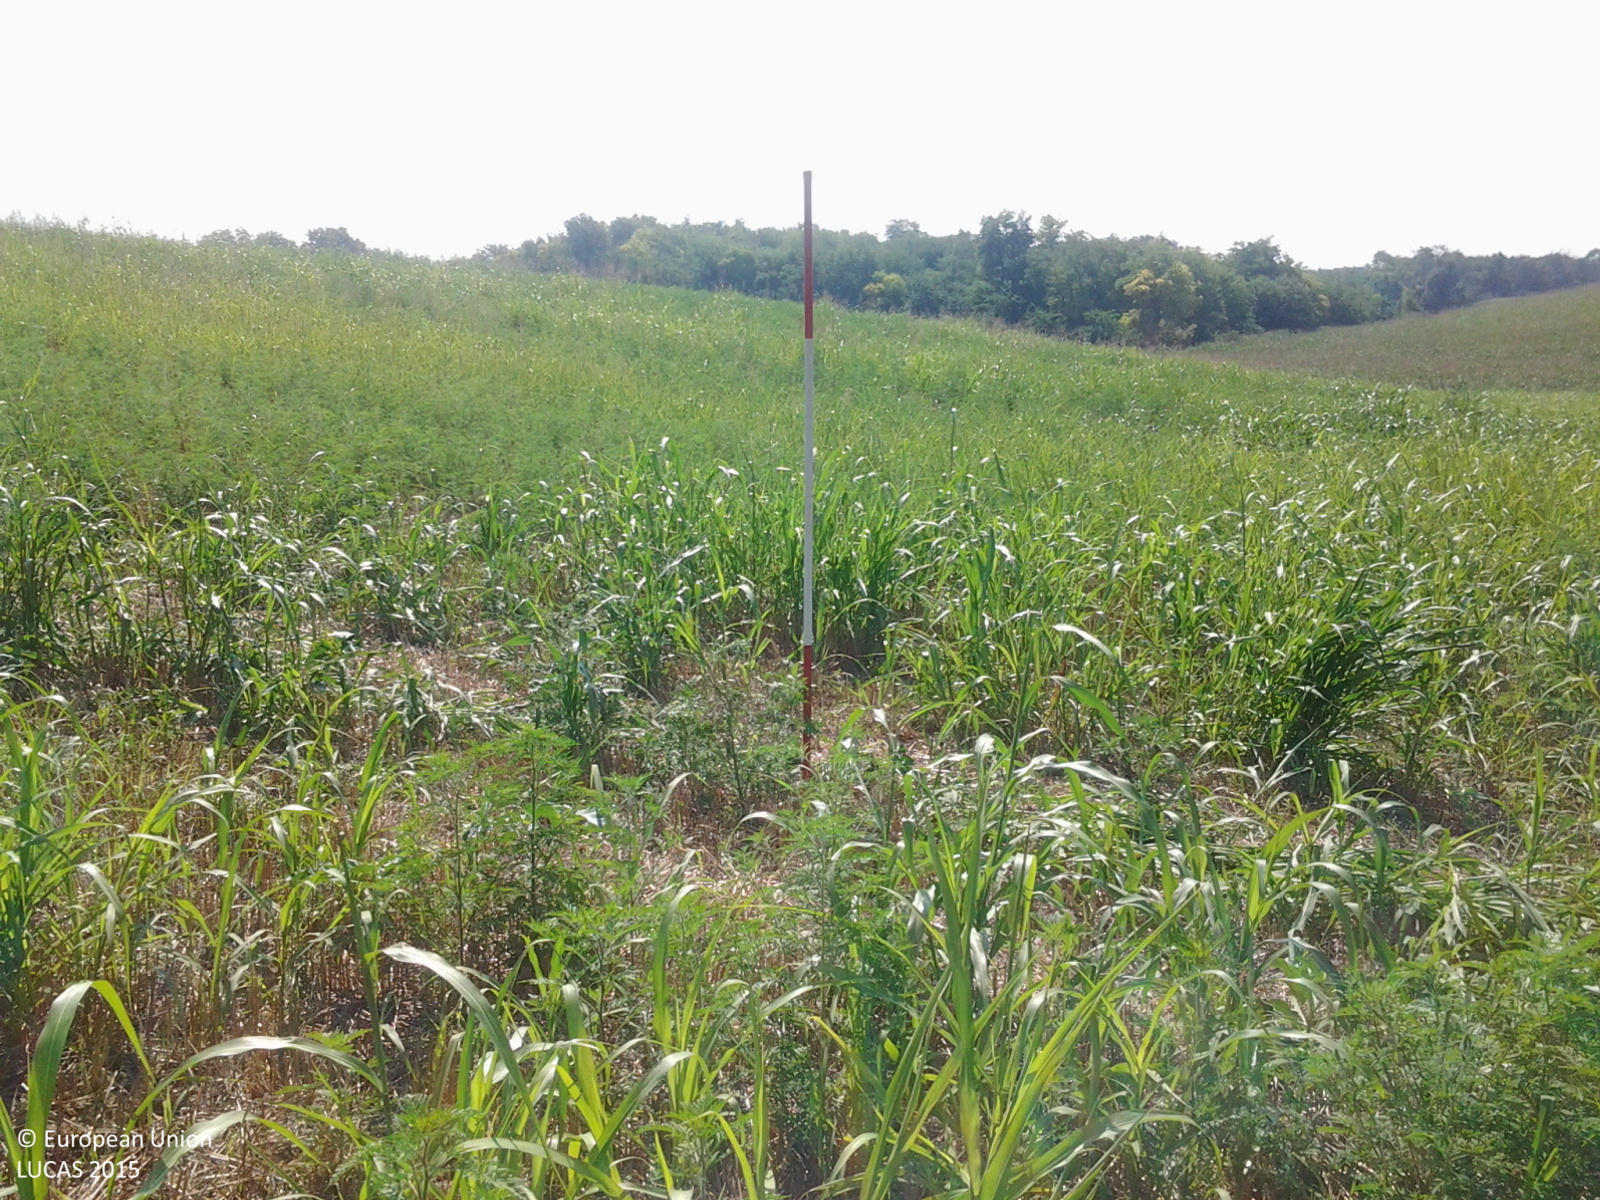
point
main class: Cropland
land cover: Common wheat
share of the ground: < 10 %
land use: Agriculture (excluding fallow land and kitchen gardens)
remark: Harvested field
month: August
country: HU
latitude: 46.7980
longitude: 18.4092
